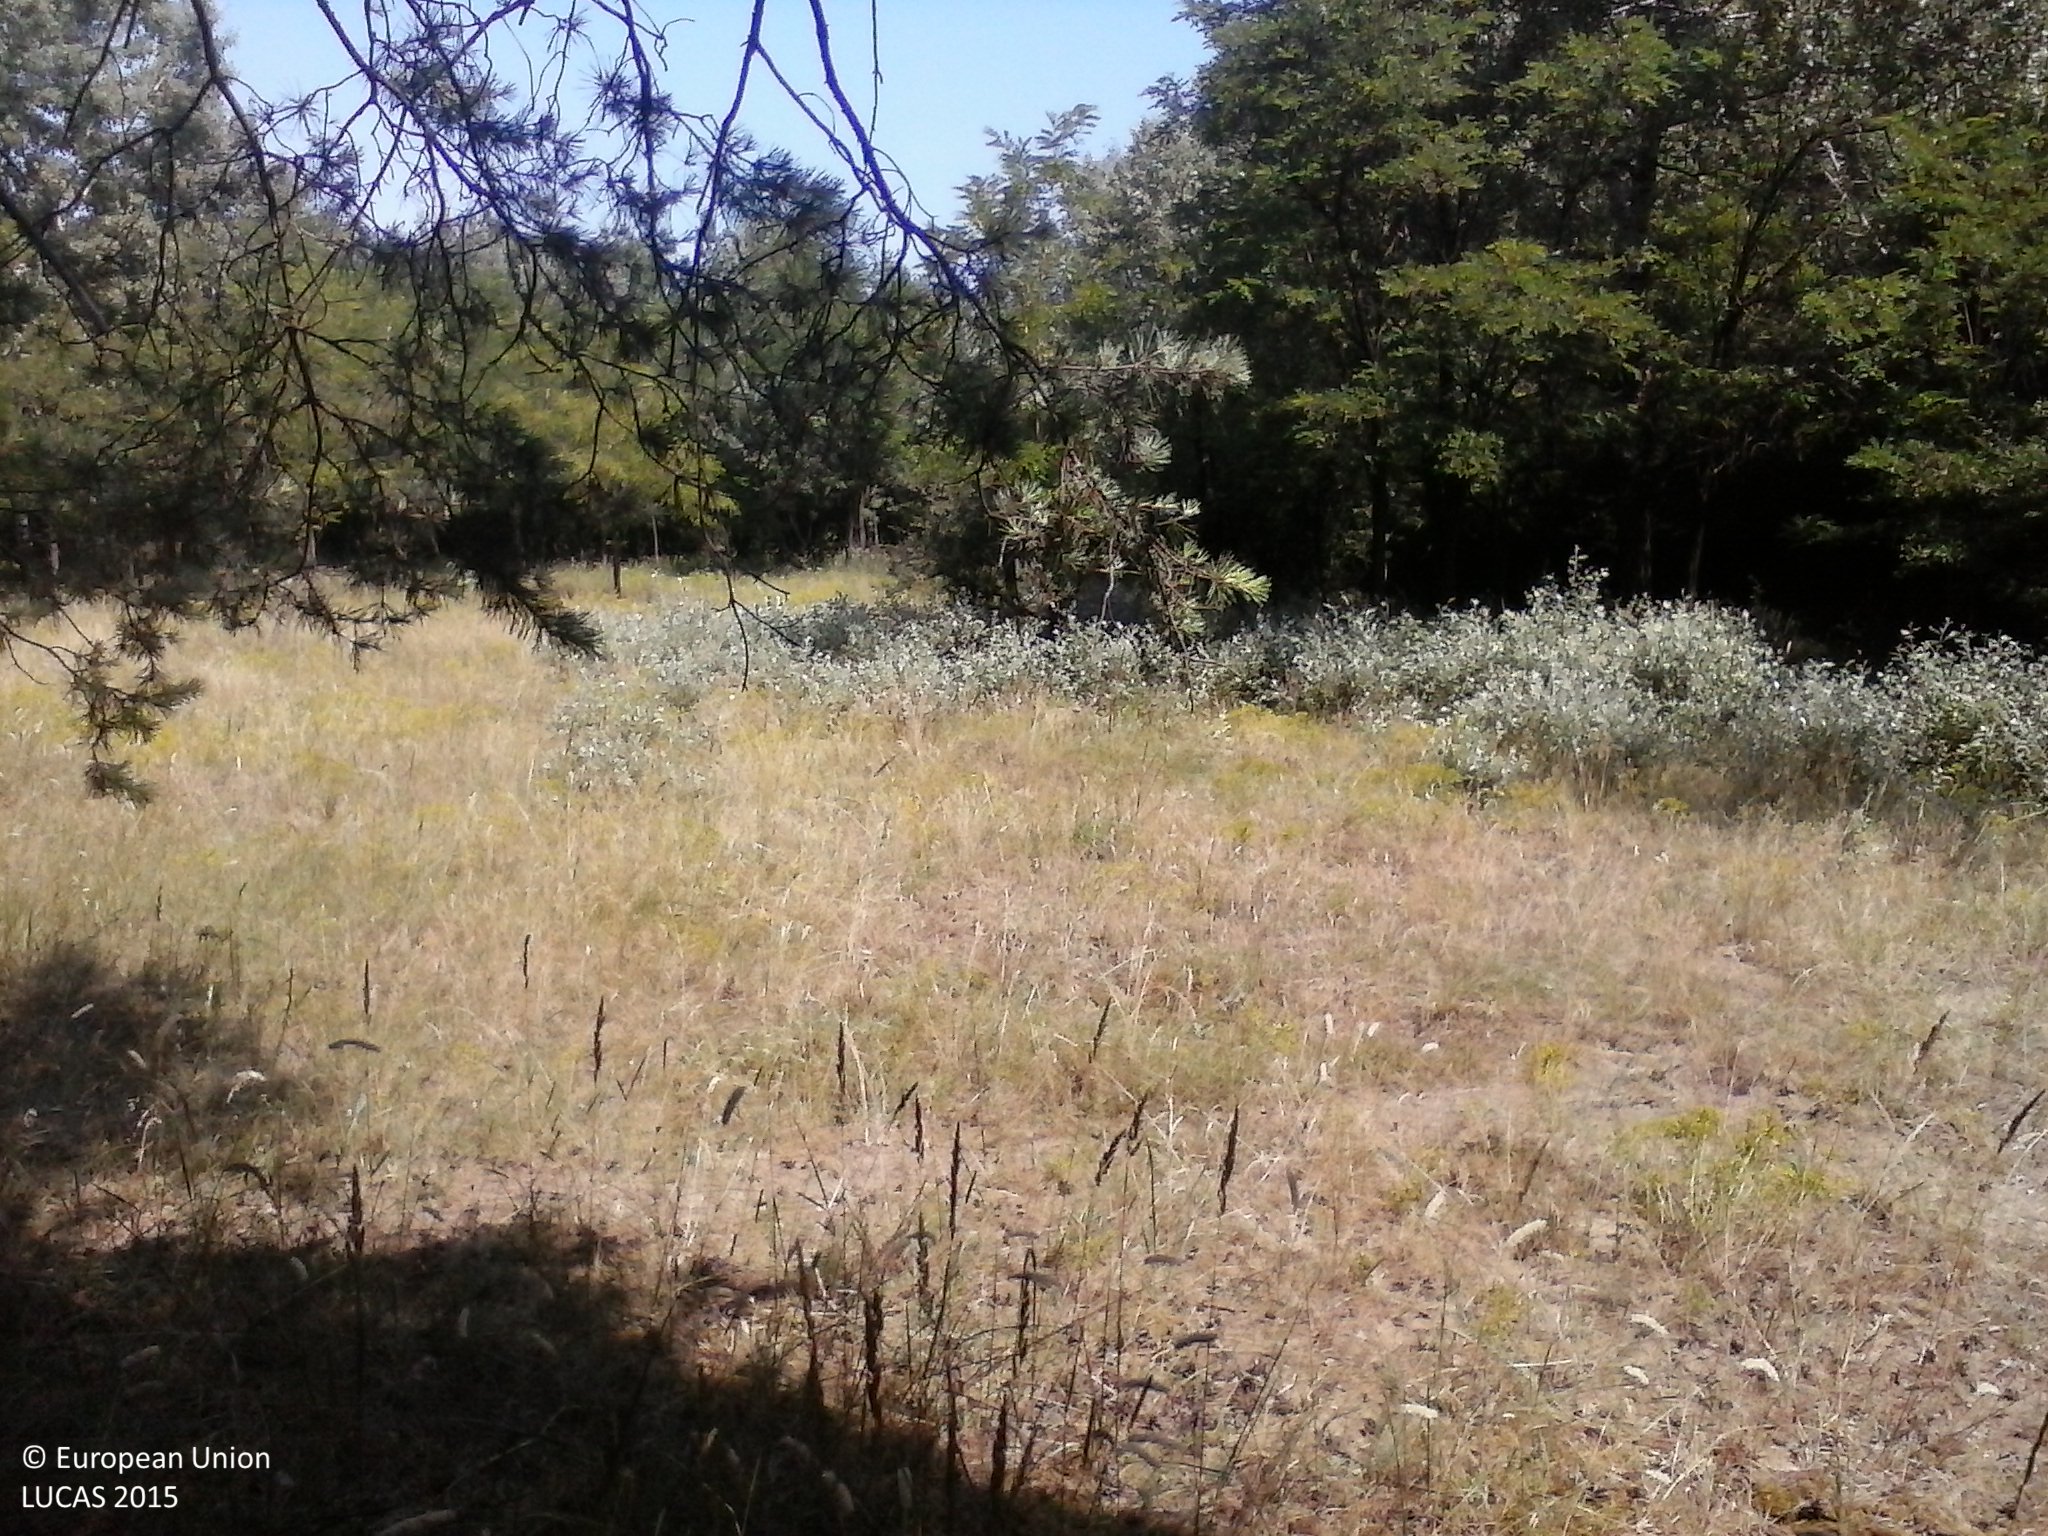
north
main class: Woodland
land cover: Pine dominated coniferous woodland
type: hemiboreal forest and nemoral coniferous forest and mixed broadleaved-coniferous forest
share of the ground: > 75 %
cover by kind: coniferous forest trees 90 %, shrubs 5 %, herbaceous plants 5 %
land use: Forestry
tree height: > 5 m
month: July
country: HU
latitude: 46.2804
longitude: 19.6082
